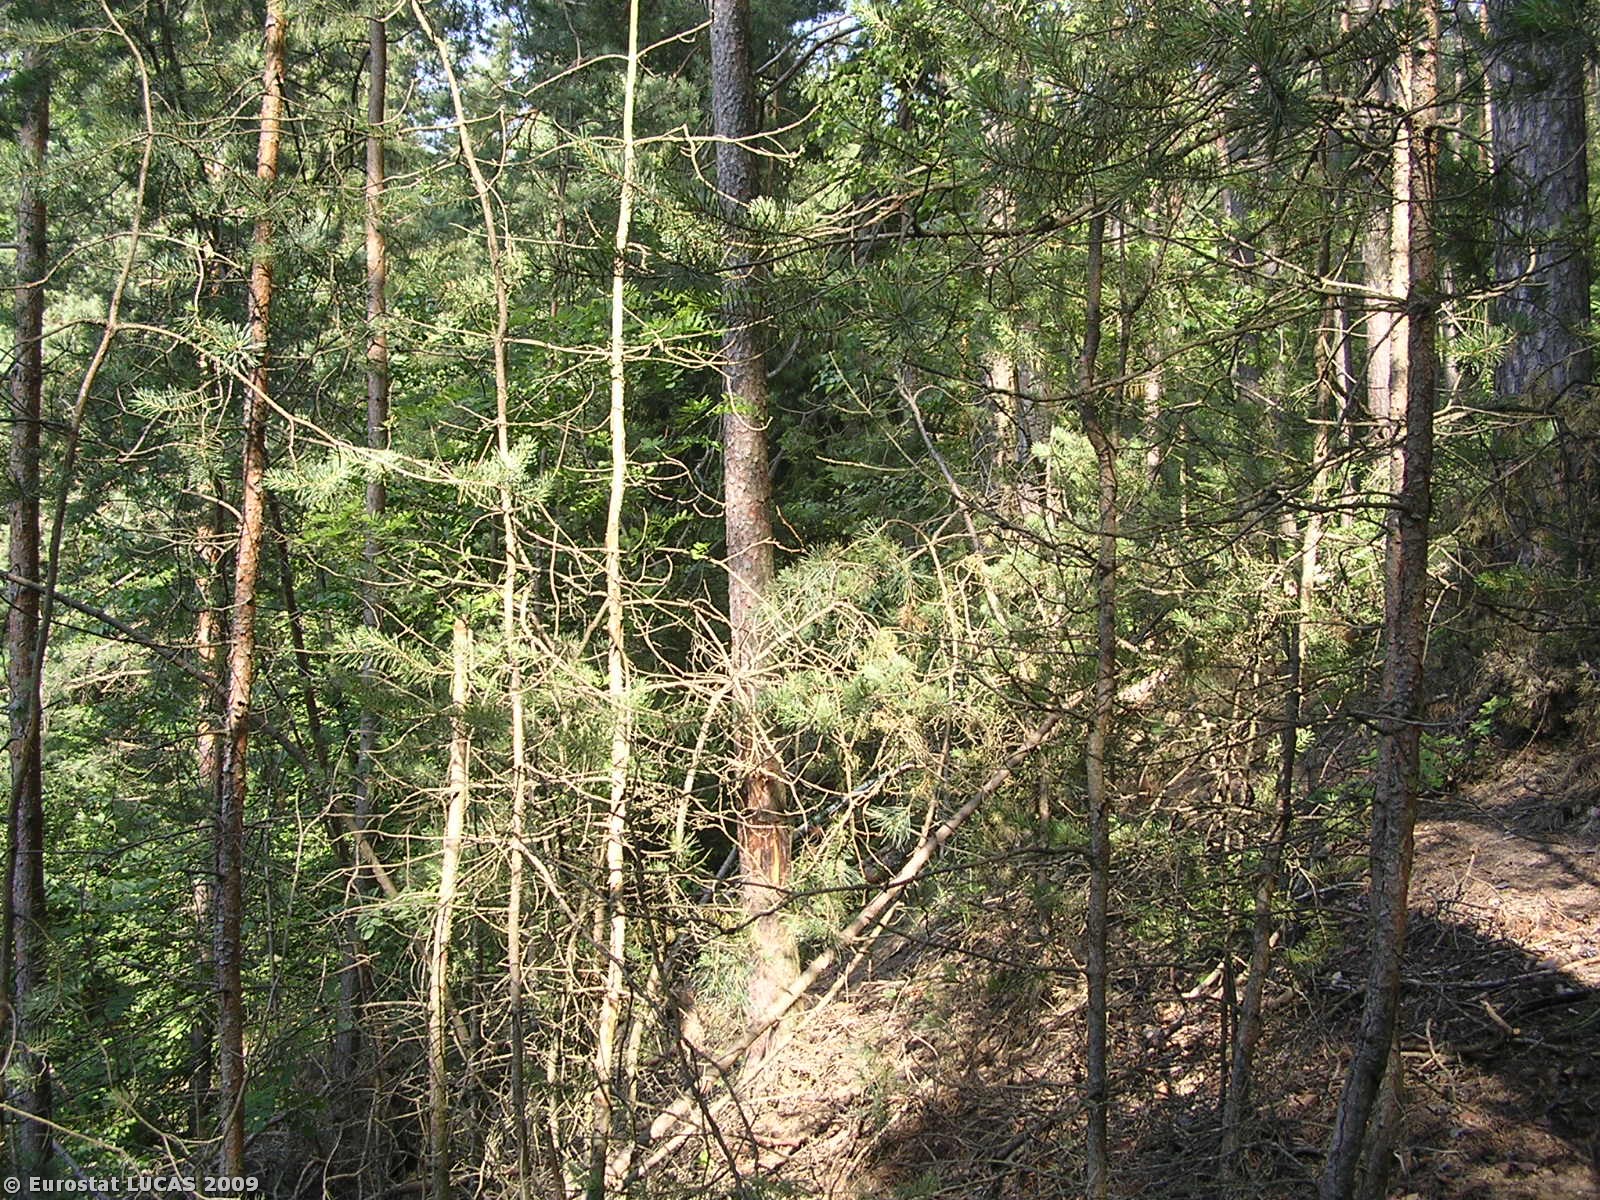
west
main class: Woodland
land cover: Coniferous woodland
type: hemiboreal forest and nemoral coniferous forest and mixed broadleaved-coniferous forest
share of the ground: > 75 %
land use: Forestry
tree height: > 5 m
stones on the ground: < 10 %
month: July
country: CZ
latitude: 50.5987
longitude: 14.9617
